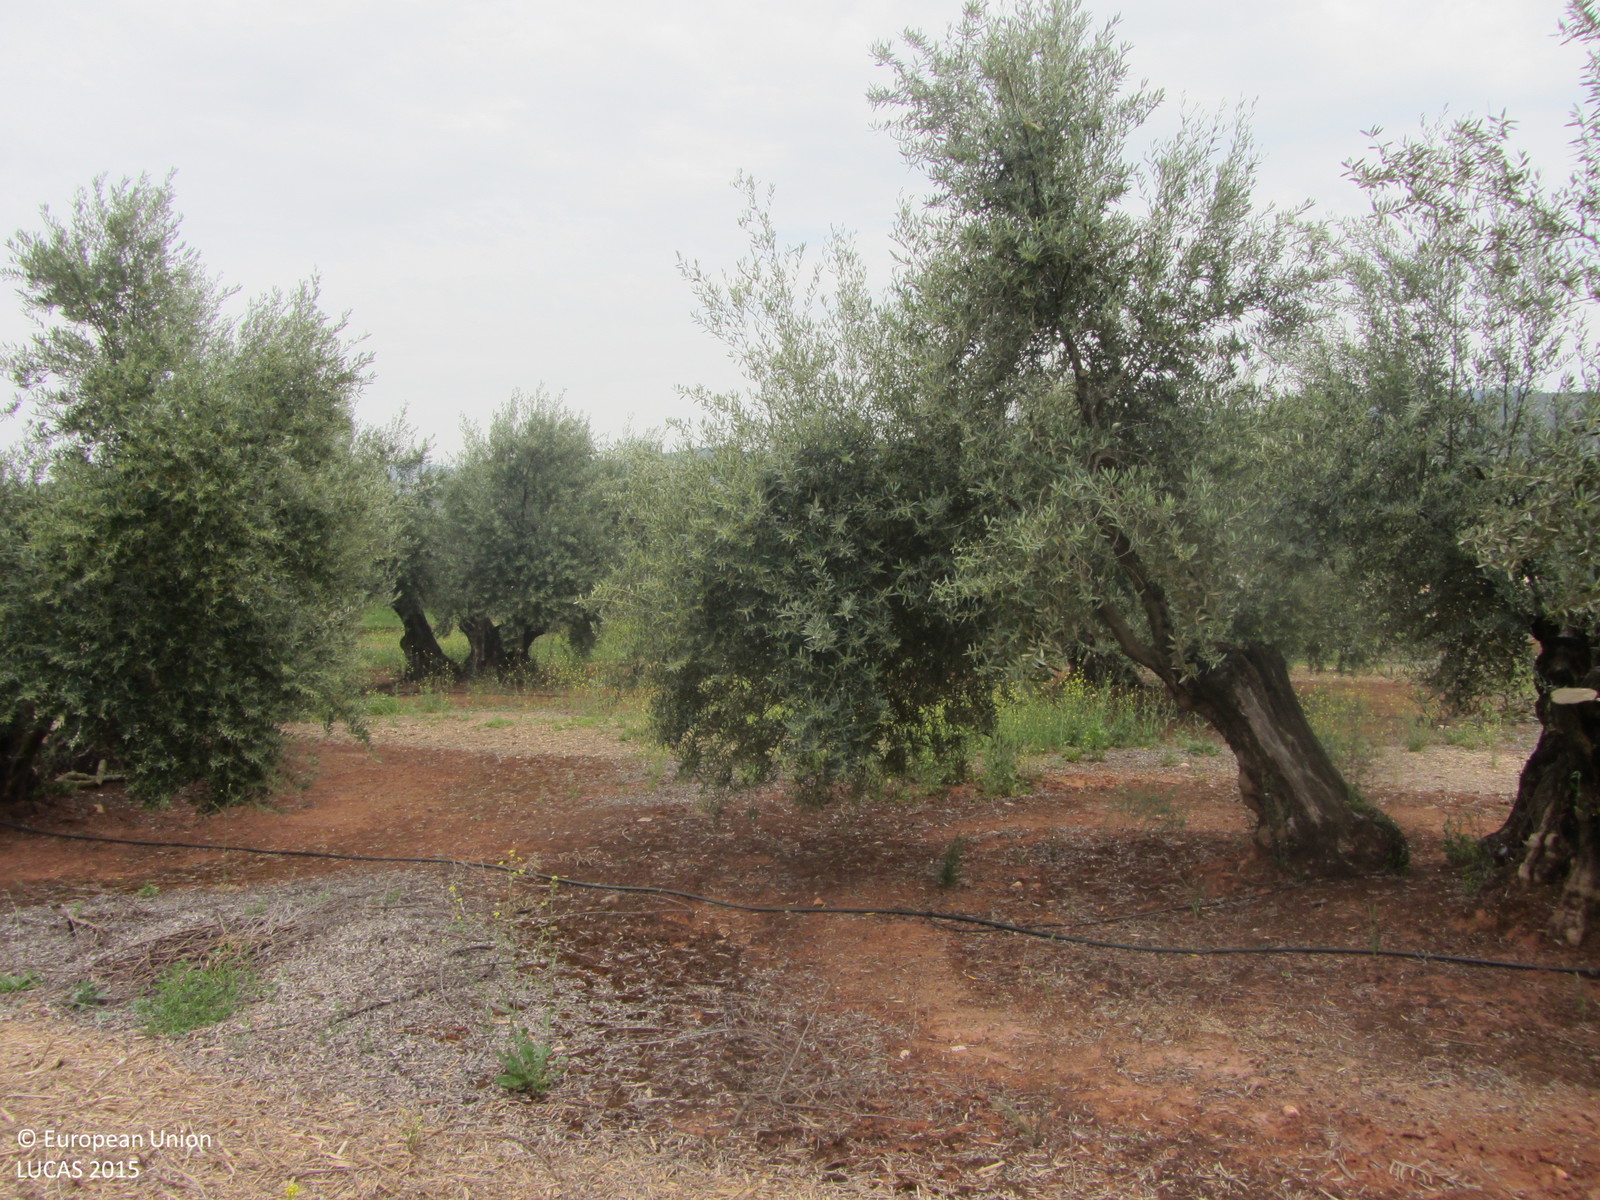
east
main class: Cropland
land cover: Olive groves
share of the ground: 25 - 50 %
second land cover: Other bare soil
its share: > 75 %
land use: Agriculture (excluding fallow land and kitchen gardens)
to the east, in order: Olive groves; Other bare soil; Grass margins; Tracks; Grass margins; Olive groves; Spontaneously vegetated surfaces; Fences; Shrubland with sparse tree cover; Inland fresh running water
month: May
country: ES
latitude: 38.2427
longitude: -3.0139
